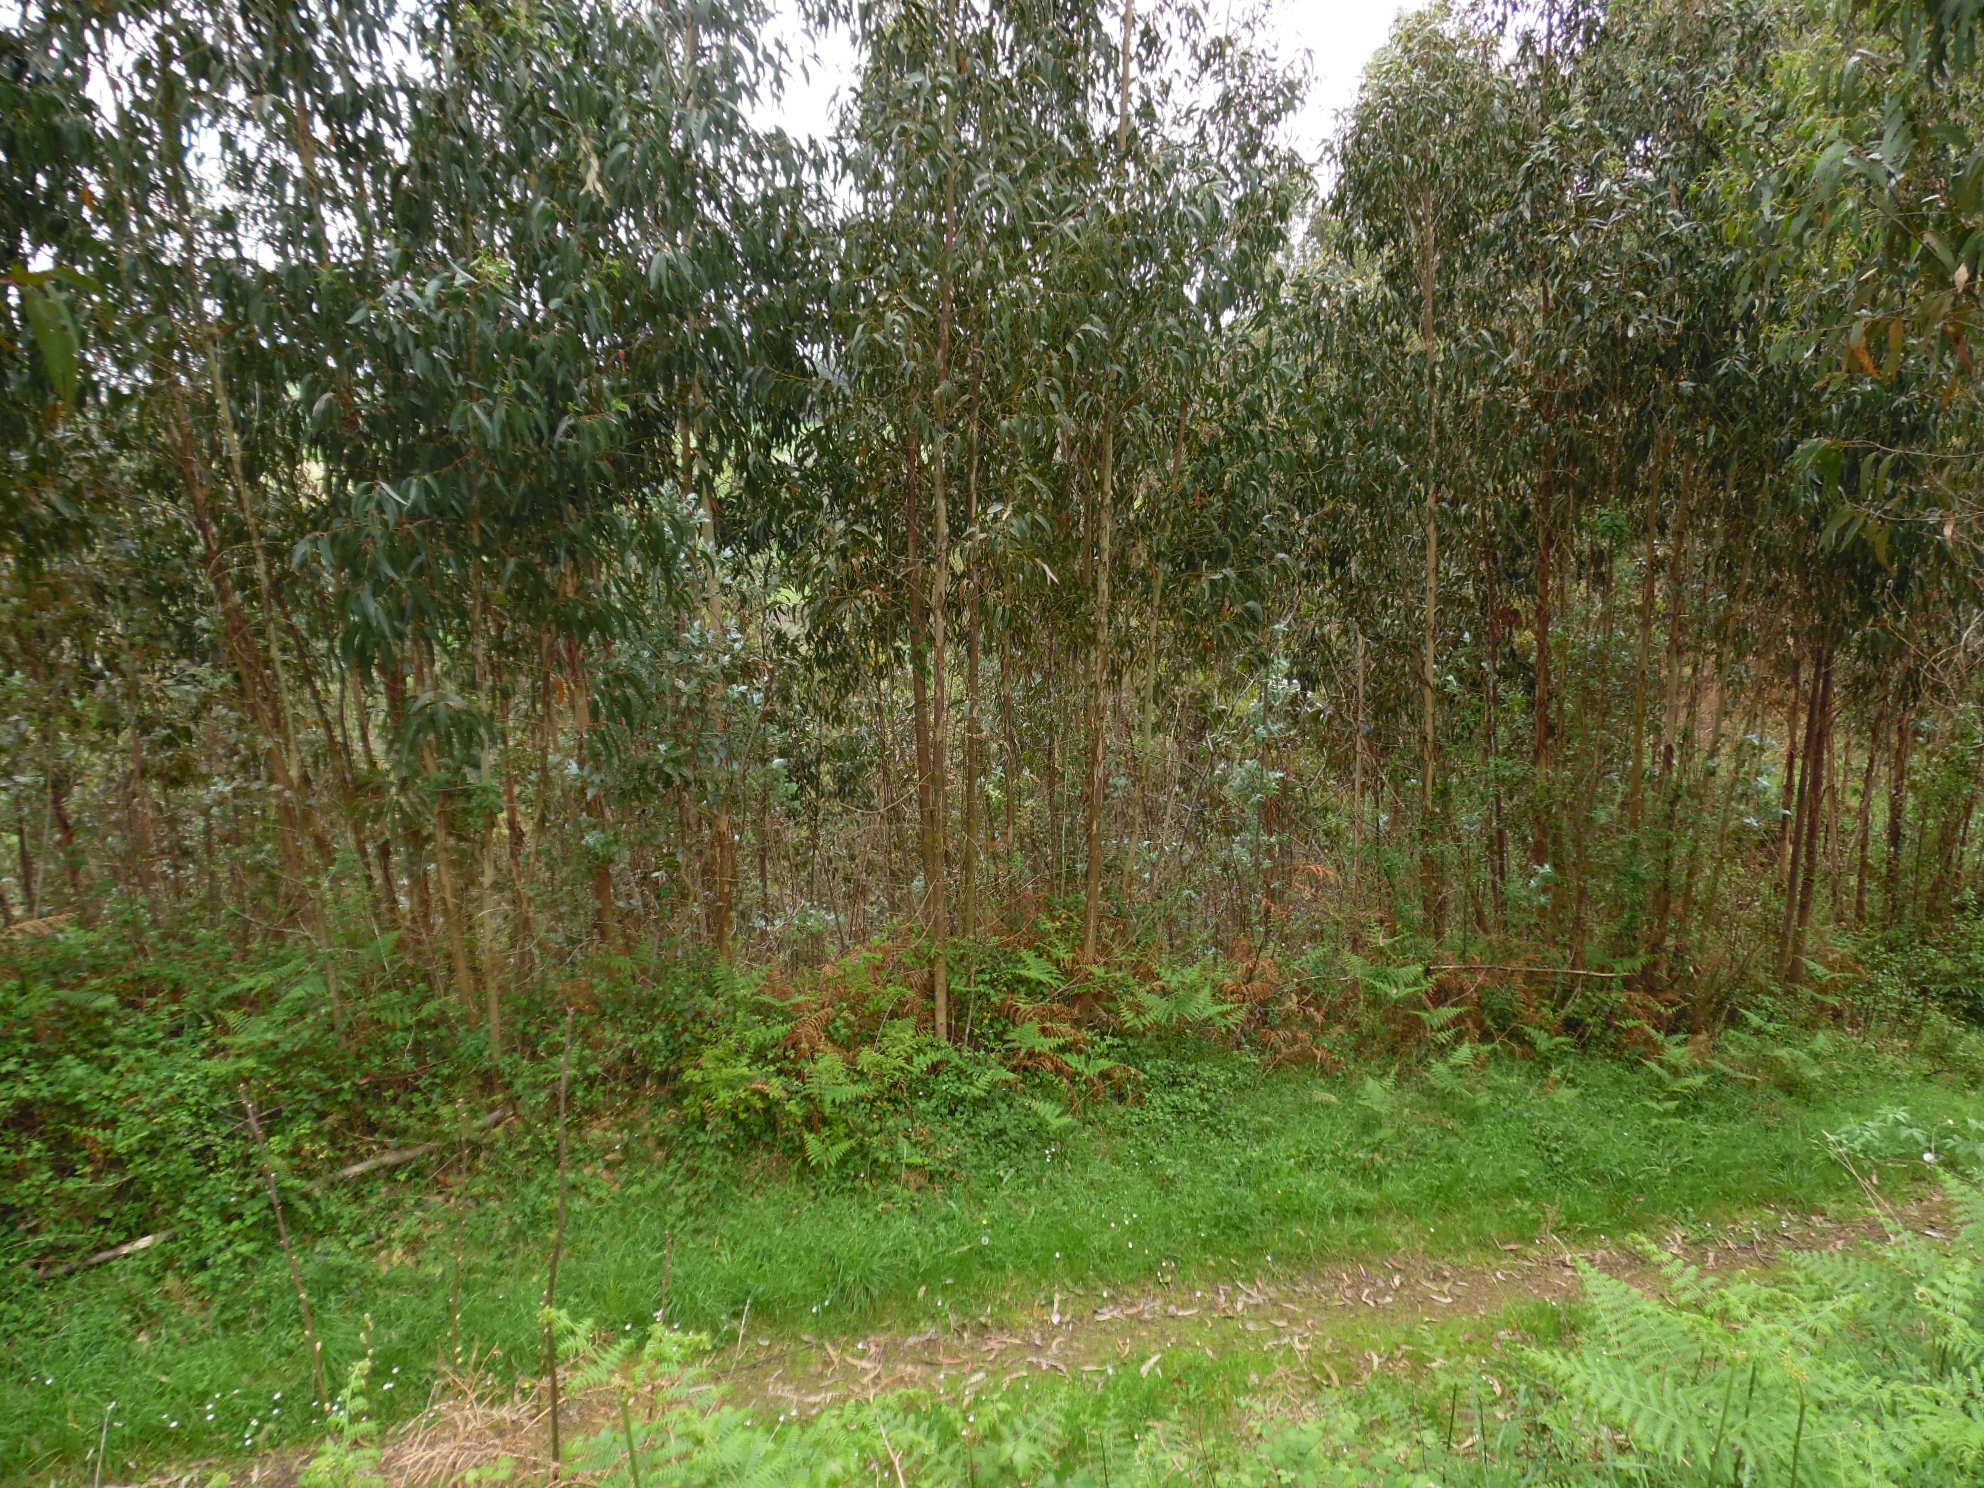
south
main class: Grassland
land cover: Grassland without tree/shrub cover
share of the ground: > 75 %
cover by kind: herbaceous plants 100 %
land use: Agriculture (excluding fallow land and kitchen gardens)
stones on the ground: 10 - 25 %
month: April
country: ES
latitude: 43.5031
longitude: -5.8842
